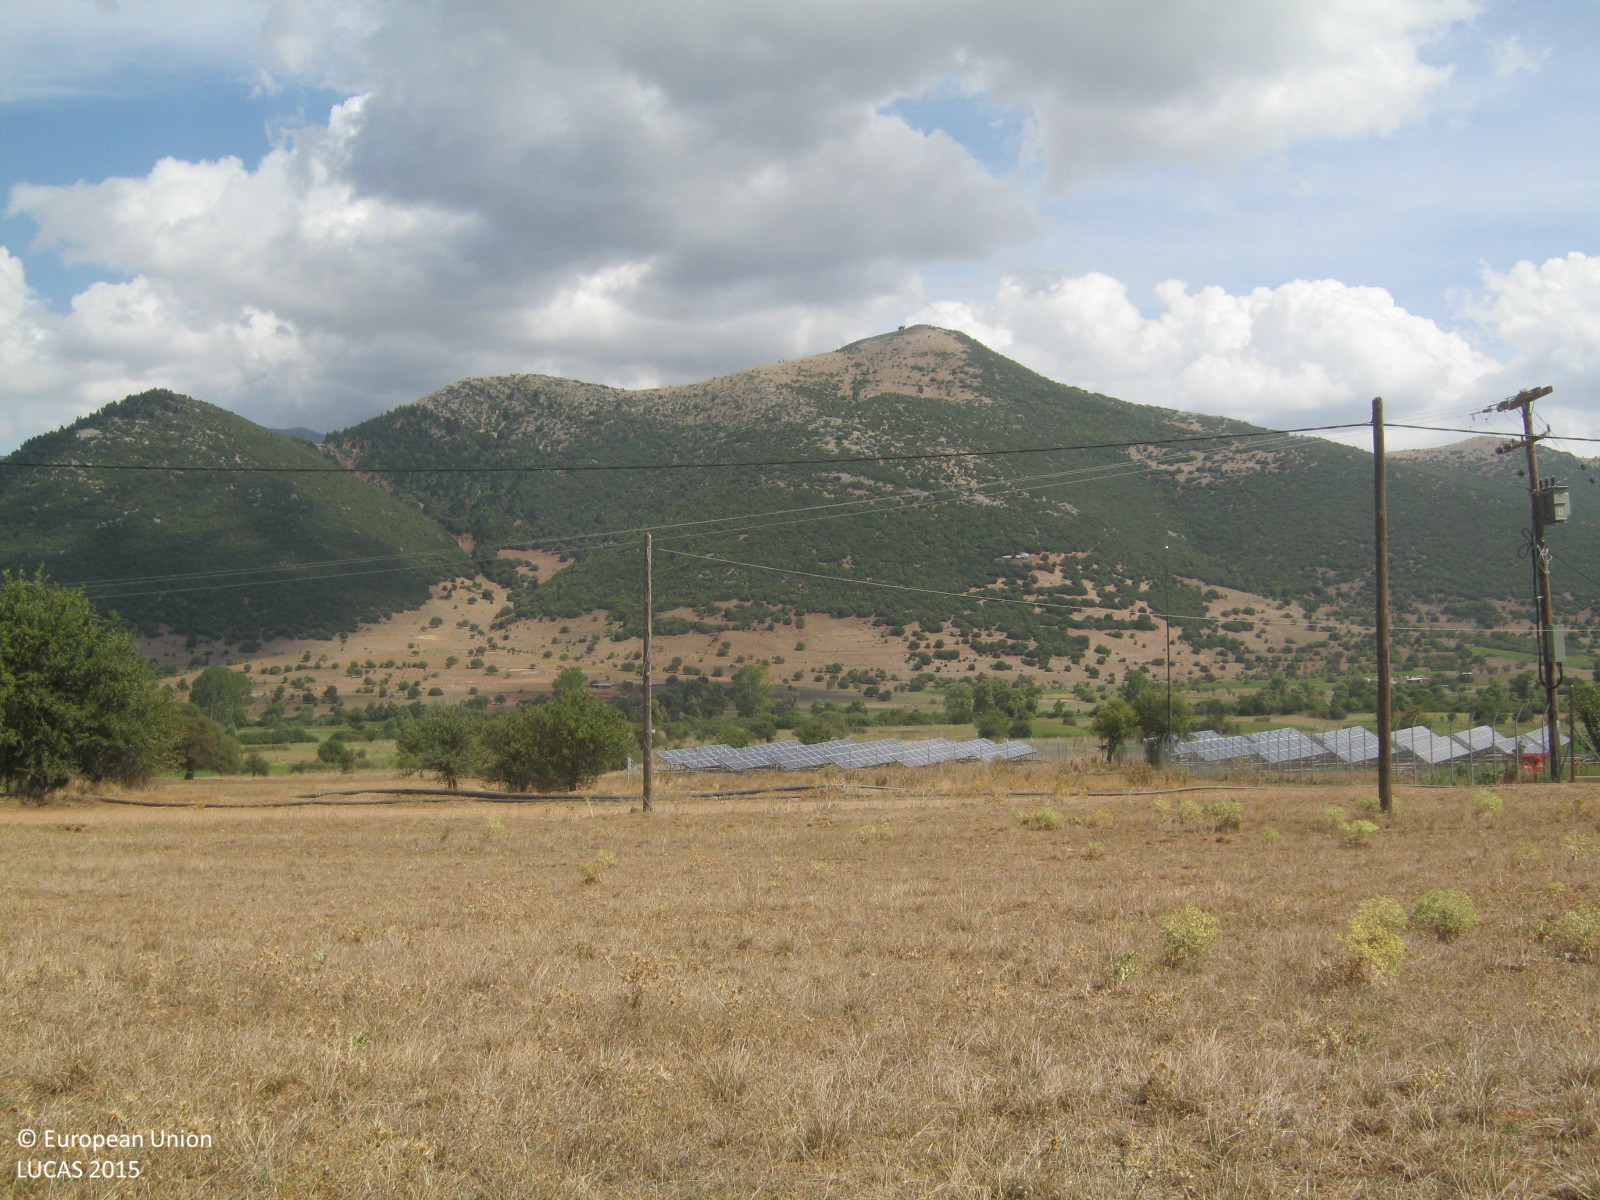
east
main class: Grassland
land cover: Spontaneously vegetated surfaces
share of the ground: > 75 %
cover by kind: herbaceous plants 95 %, unconsolidated bare surface 5 %
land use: Agriculture (excluding fallow land and kitchen gardens)
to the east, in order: Spontaneously vegetated surfaces; Electric lines; Spontaneously vegetated surfaces; Tracks; Spontaneously vegetated surfaces; Electric lines; Spontaneously vegetated surfaces; Fences; Spontaneously vegetated surfaces; Artificial constructions in urban areas; Spontaneously vegetated surfaces; Fences; Spontaneously vegetated surfaces
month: September
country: GR
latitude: 37.9623
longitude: 22.0880
